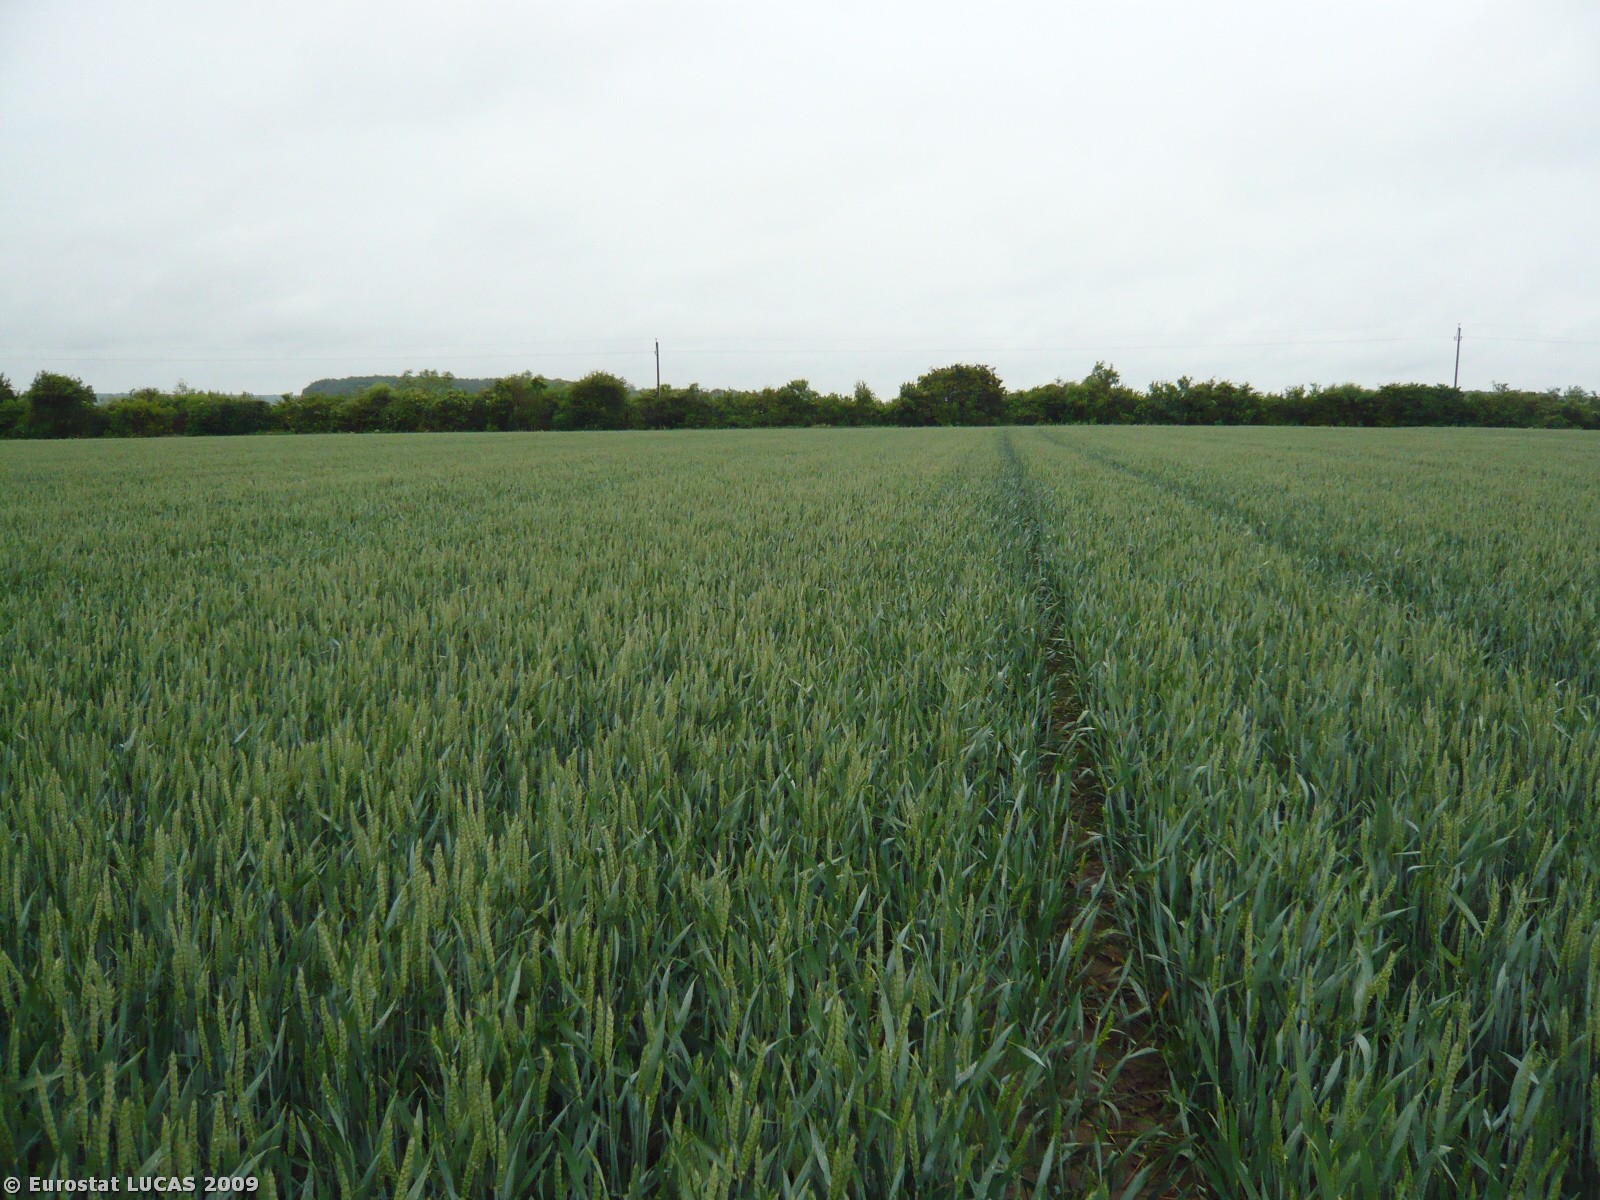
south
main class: Cropland
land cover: Common wheat
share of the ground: > 75 %
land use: Agriculture (excluding fallow land and kitchen gardens)
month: June
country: DK
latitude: 54.8624
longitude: 11.8216
